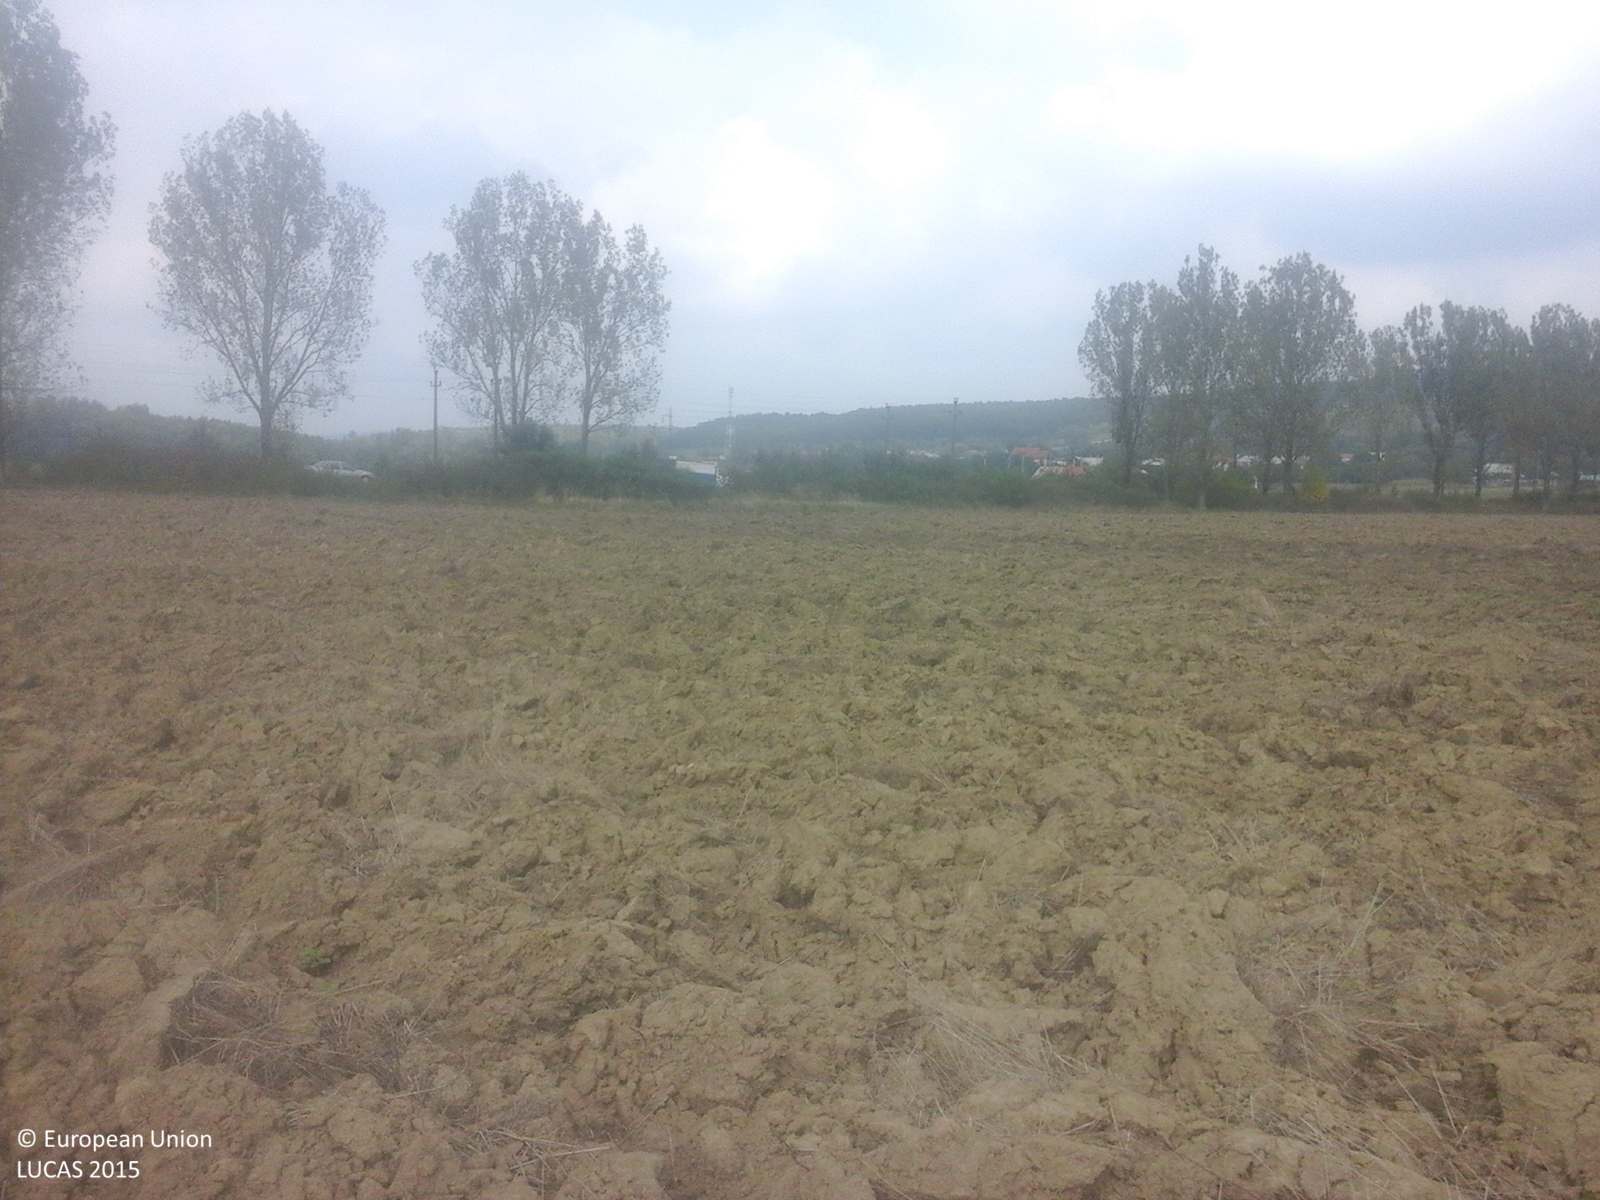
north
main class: Grassland
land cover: Grassland without tree/shrub cover
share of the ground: < 10 %
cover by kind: herbaceous plants 100 %
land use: Agriculture (excluding fallow land and kitchen gardens)
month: September
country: RO
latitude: 44.6804
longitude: 23.4136
